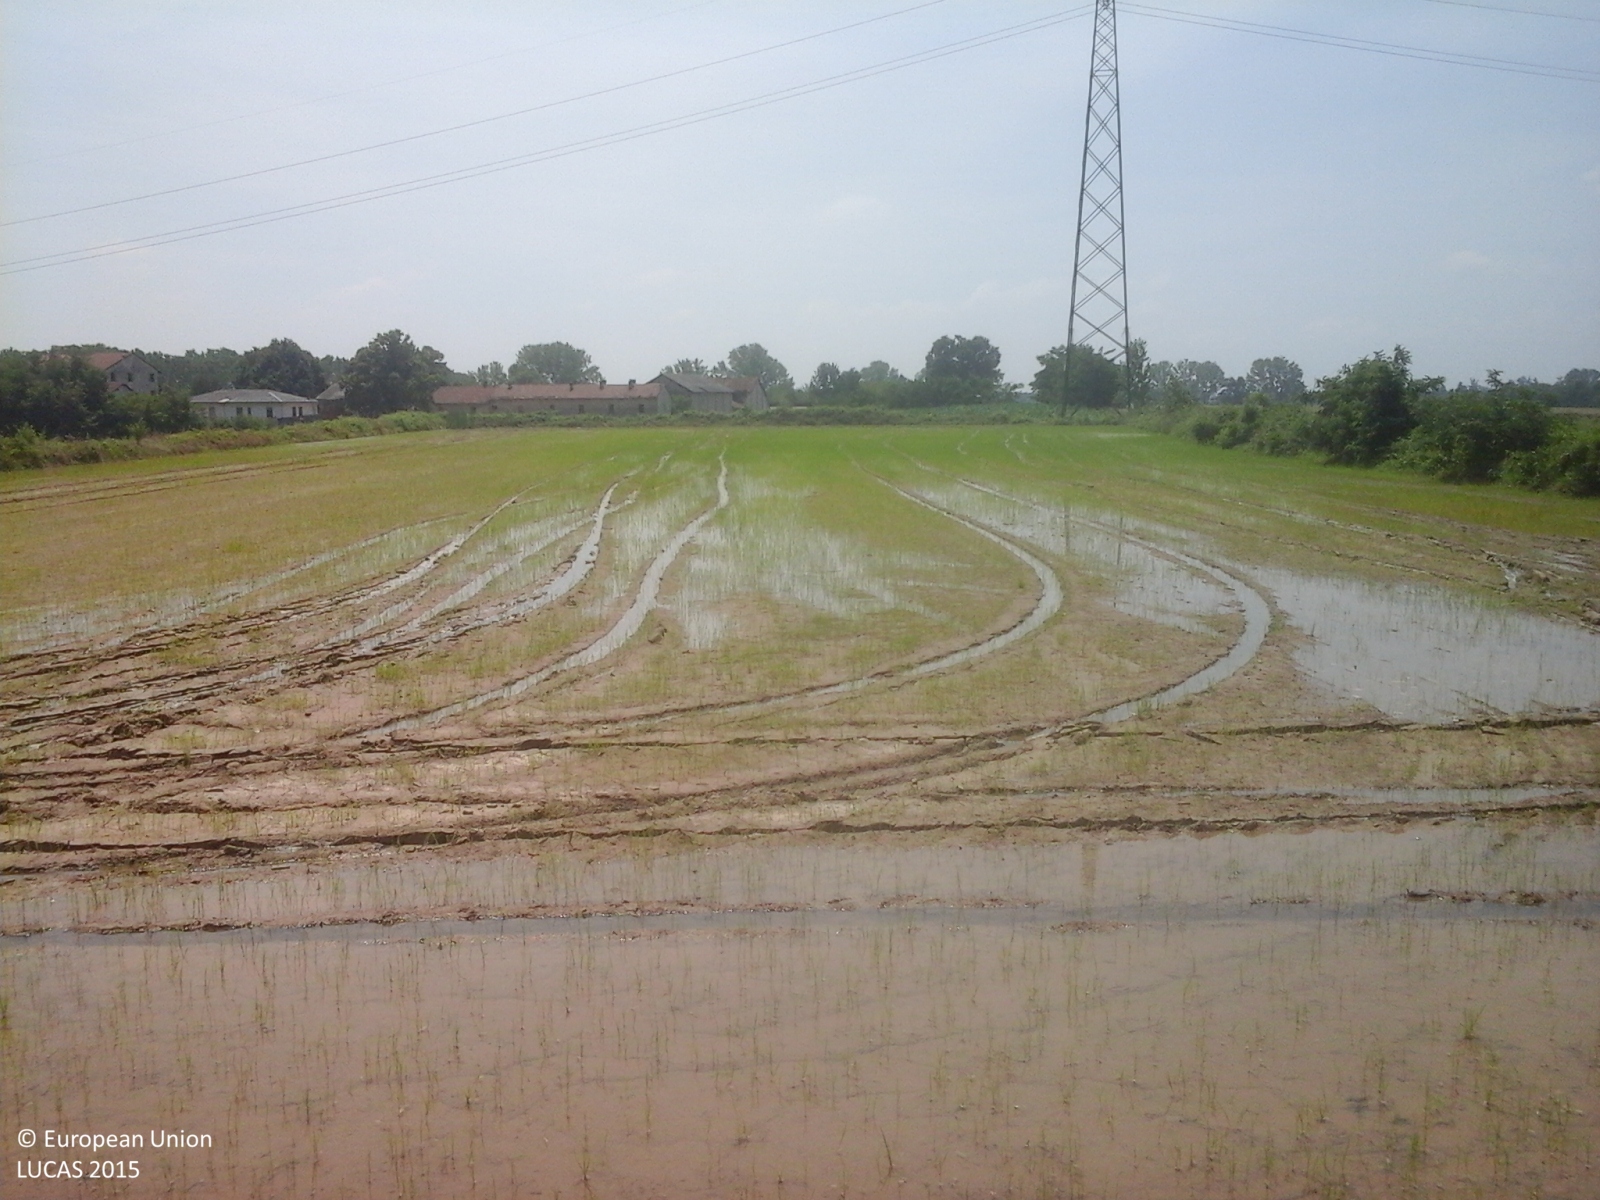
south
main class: Cropland
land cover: Rice
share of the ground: 50 - 75 %
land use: Agriculture (excluding fallow land and kitchen gardens)
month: June
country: IT
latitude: 45.4055
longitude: 8.6353
